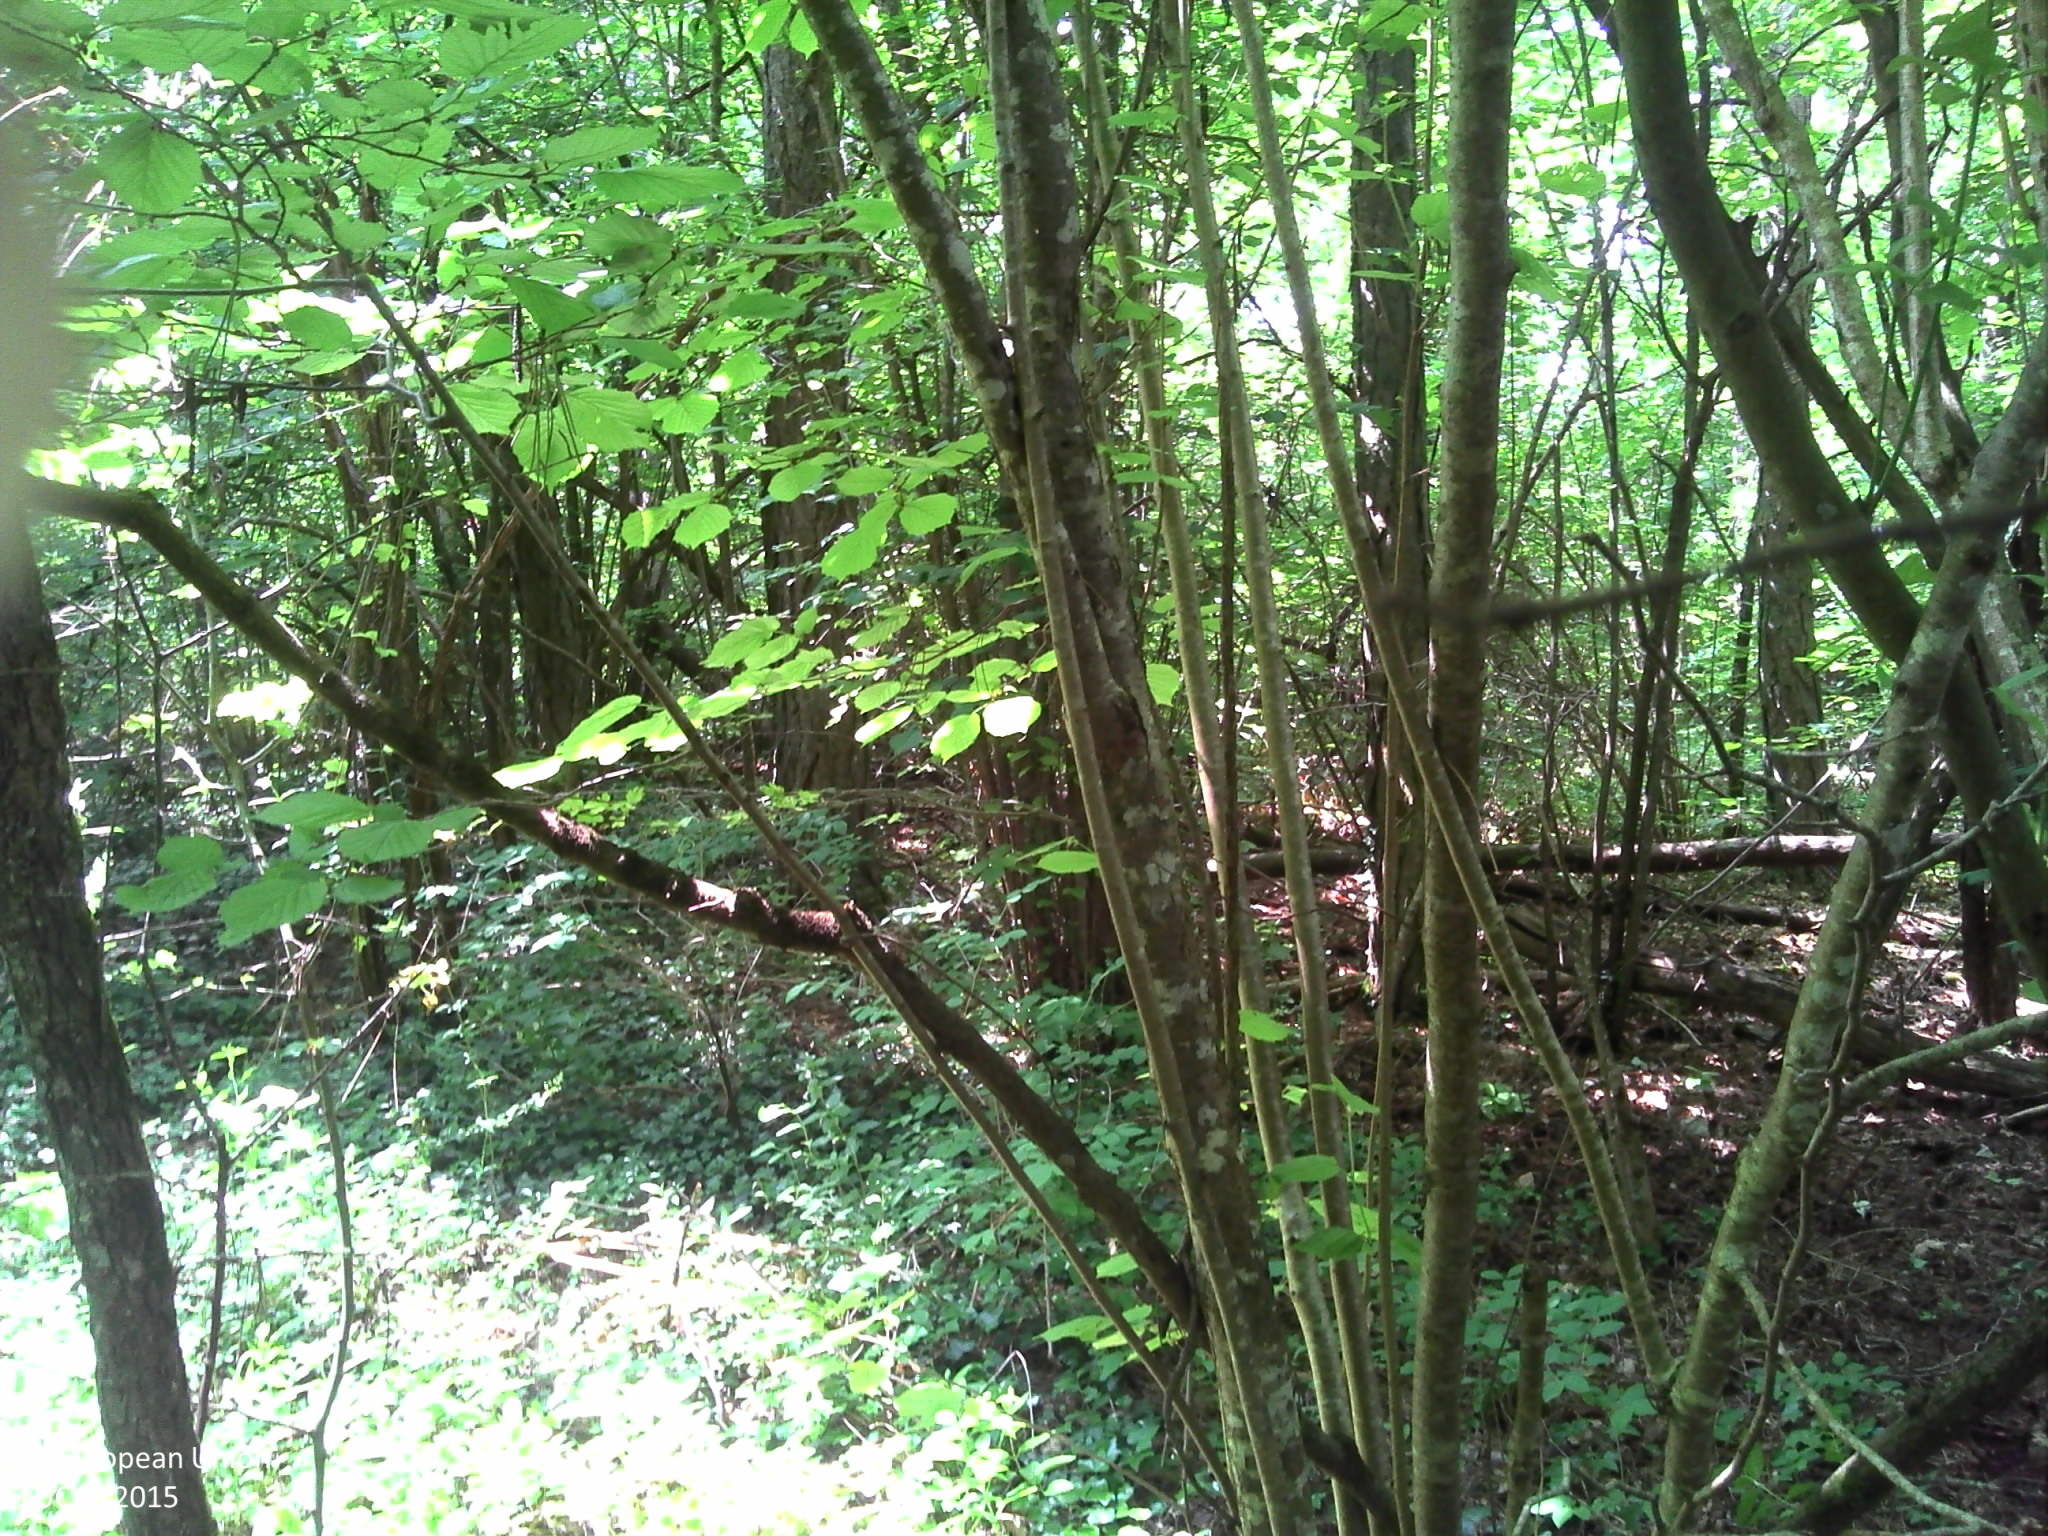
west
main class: Woodland
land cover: Broadleaved woodland
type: acidophilous oak and oak-birch forest
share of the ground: > 75 %
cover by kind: broadleaved forest trees 70 %, coniferous forest trees 20 %, herbaceous plants 5 %, lichens and mosses 5 %
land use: Semi-natural and natural areas not in use
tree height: > 5 m
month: May
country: FR
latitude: 47.7629
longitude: 3.8462
